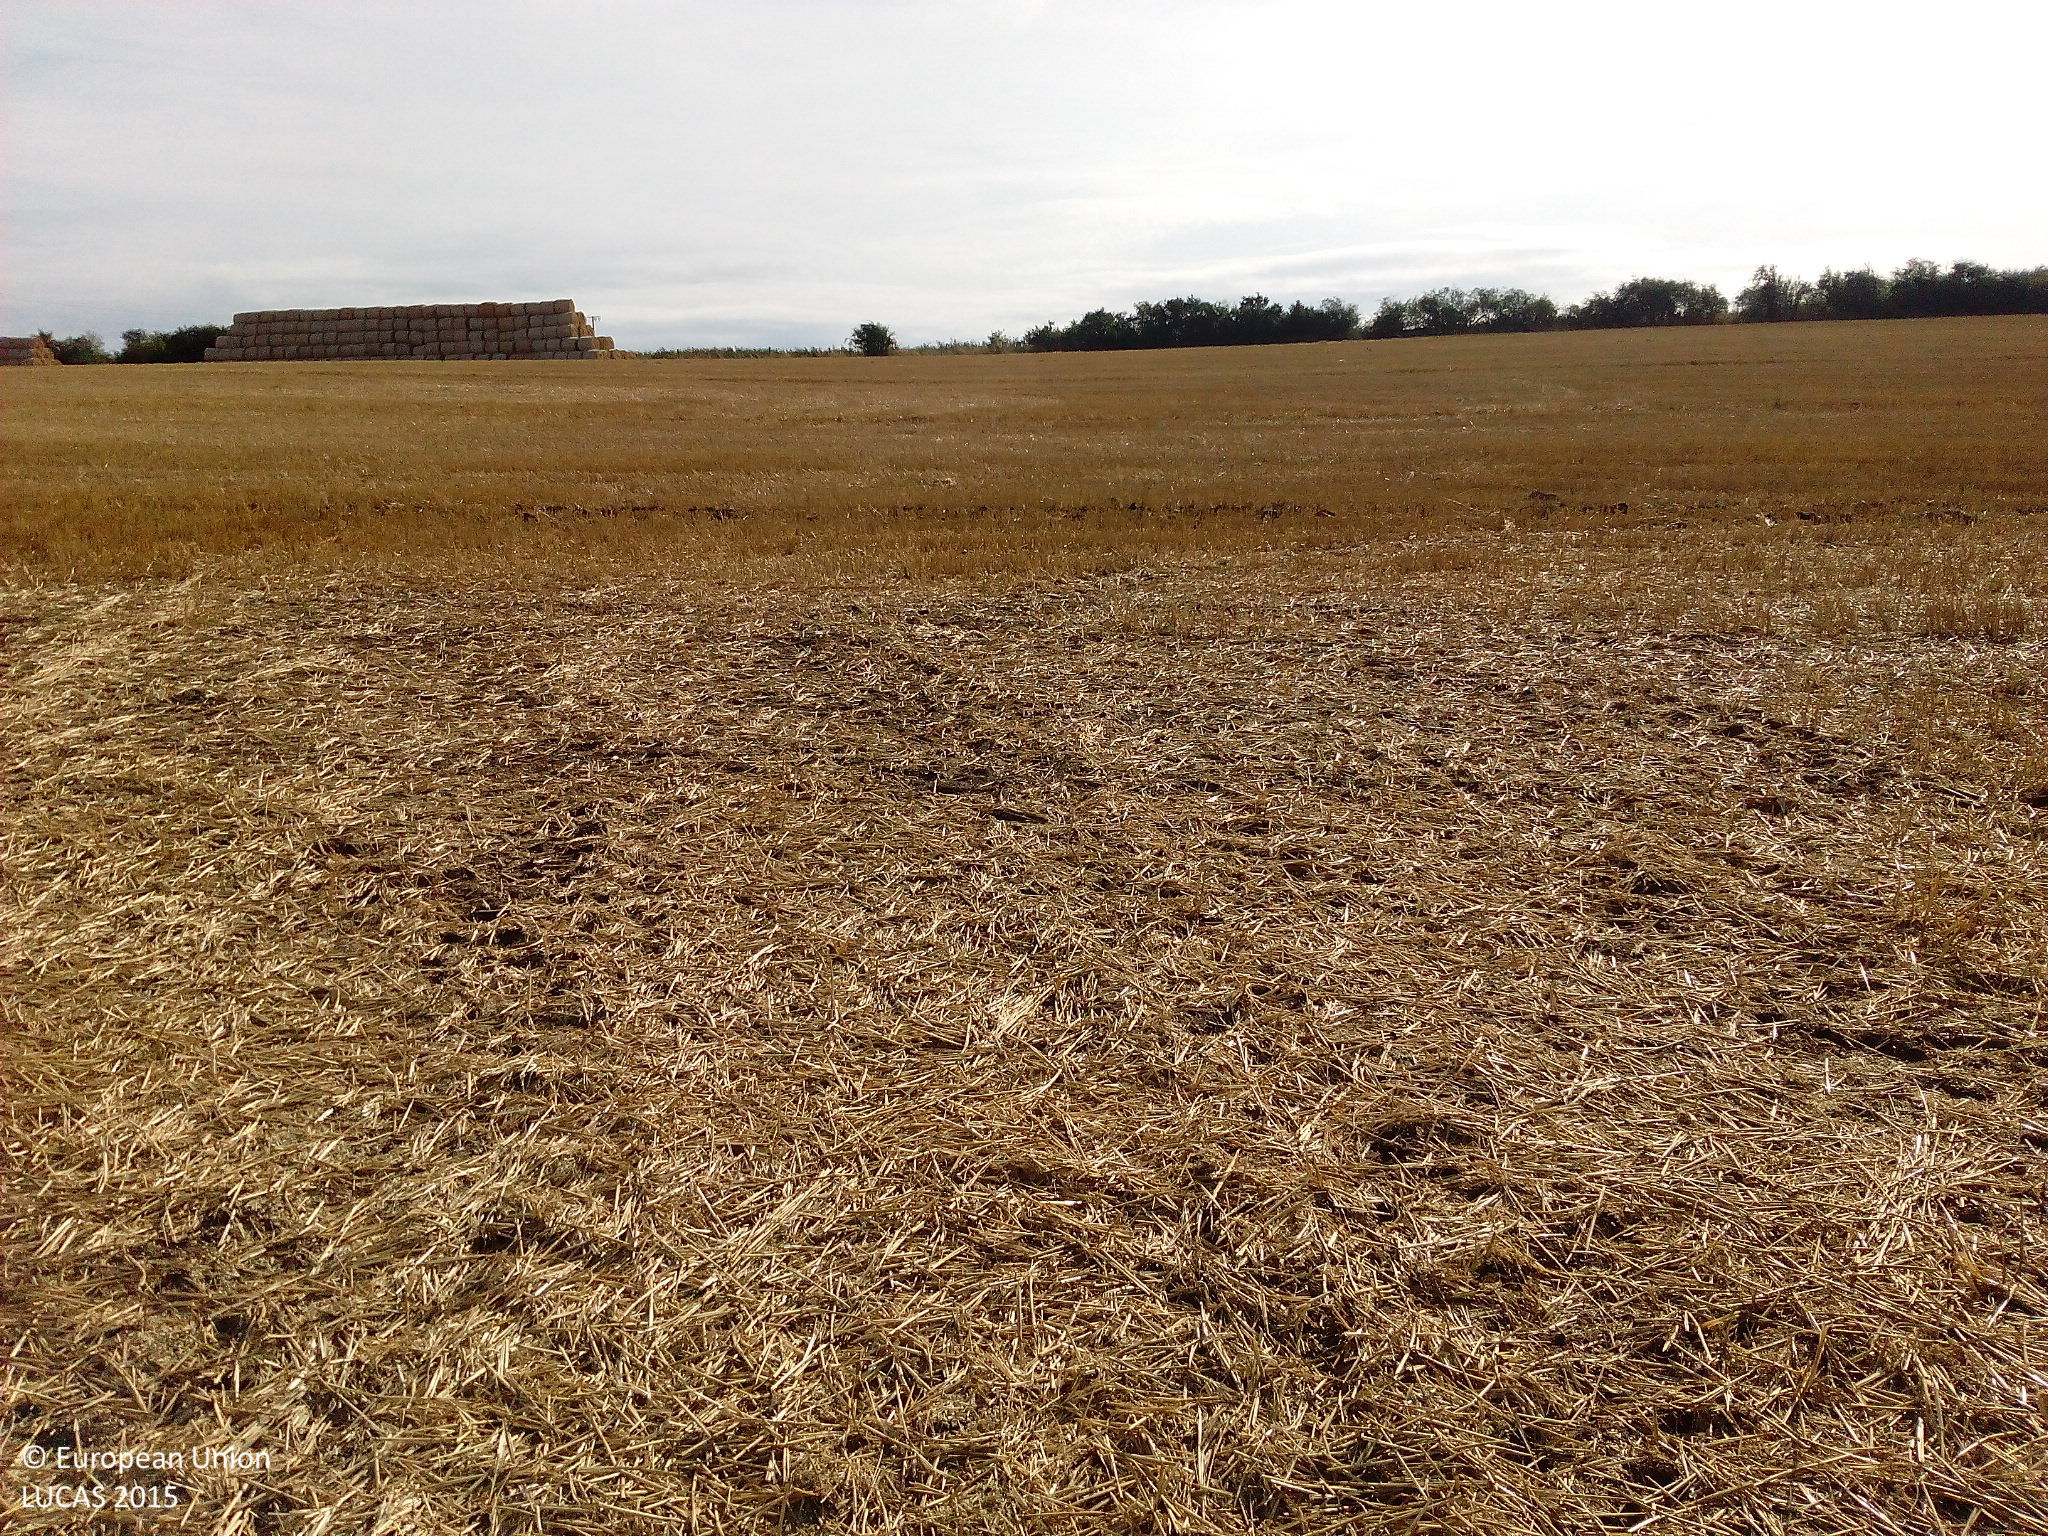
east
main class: Cropland
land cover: Common wheat
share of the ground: 50 - 75 %
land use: Agriculture (excluding fallow land and kitchen gardens)
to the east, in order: Common wheat; Grass margins; Shruby margins; Fences; Shruby margins; Tracks; Shruby margins; Fences; Shruby margins; Maize
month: August
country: DE
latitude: 53.8576
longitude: 12.6903
